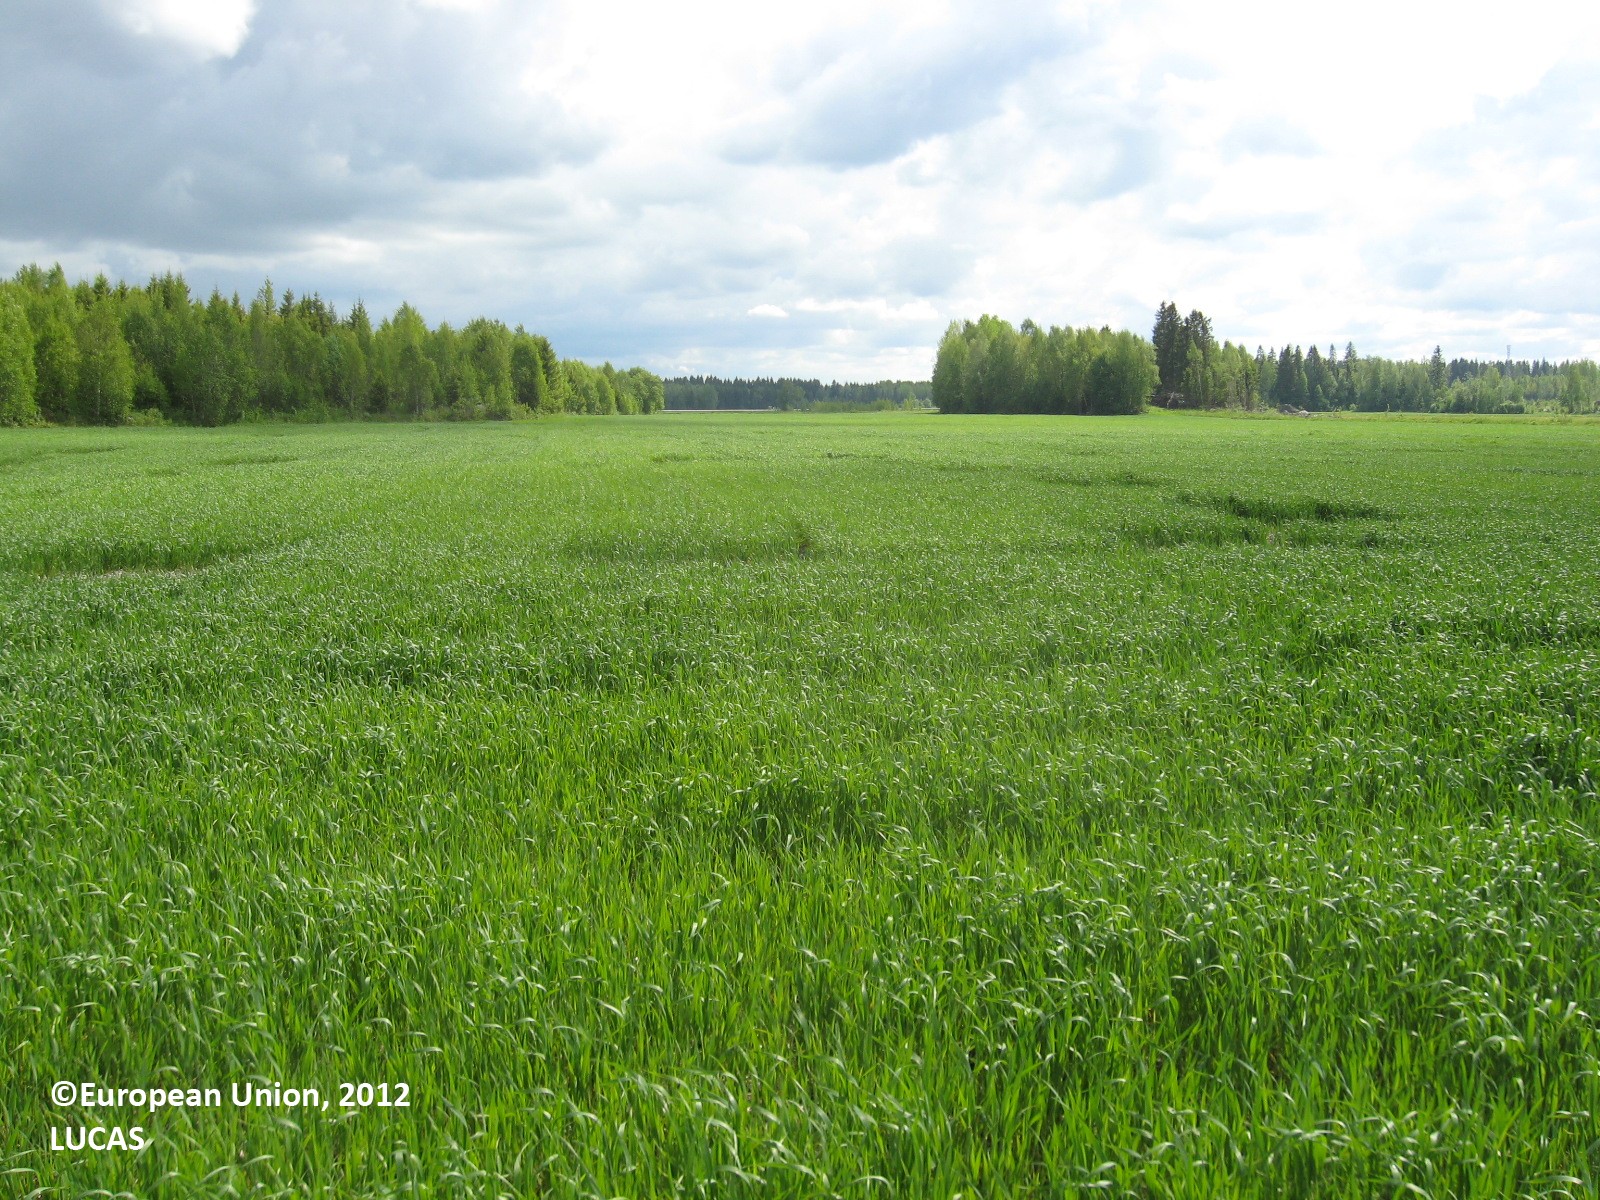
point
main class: Cropland
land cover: Triticale
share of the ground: > 75 %
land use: Agriculture (excluding fallow land and kitchen gardens)
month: June
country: FI
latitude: 63.0770
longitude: 21.8209
